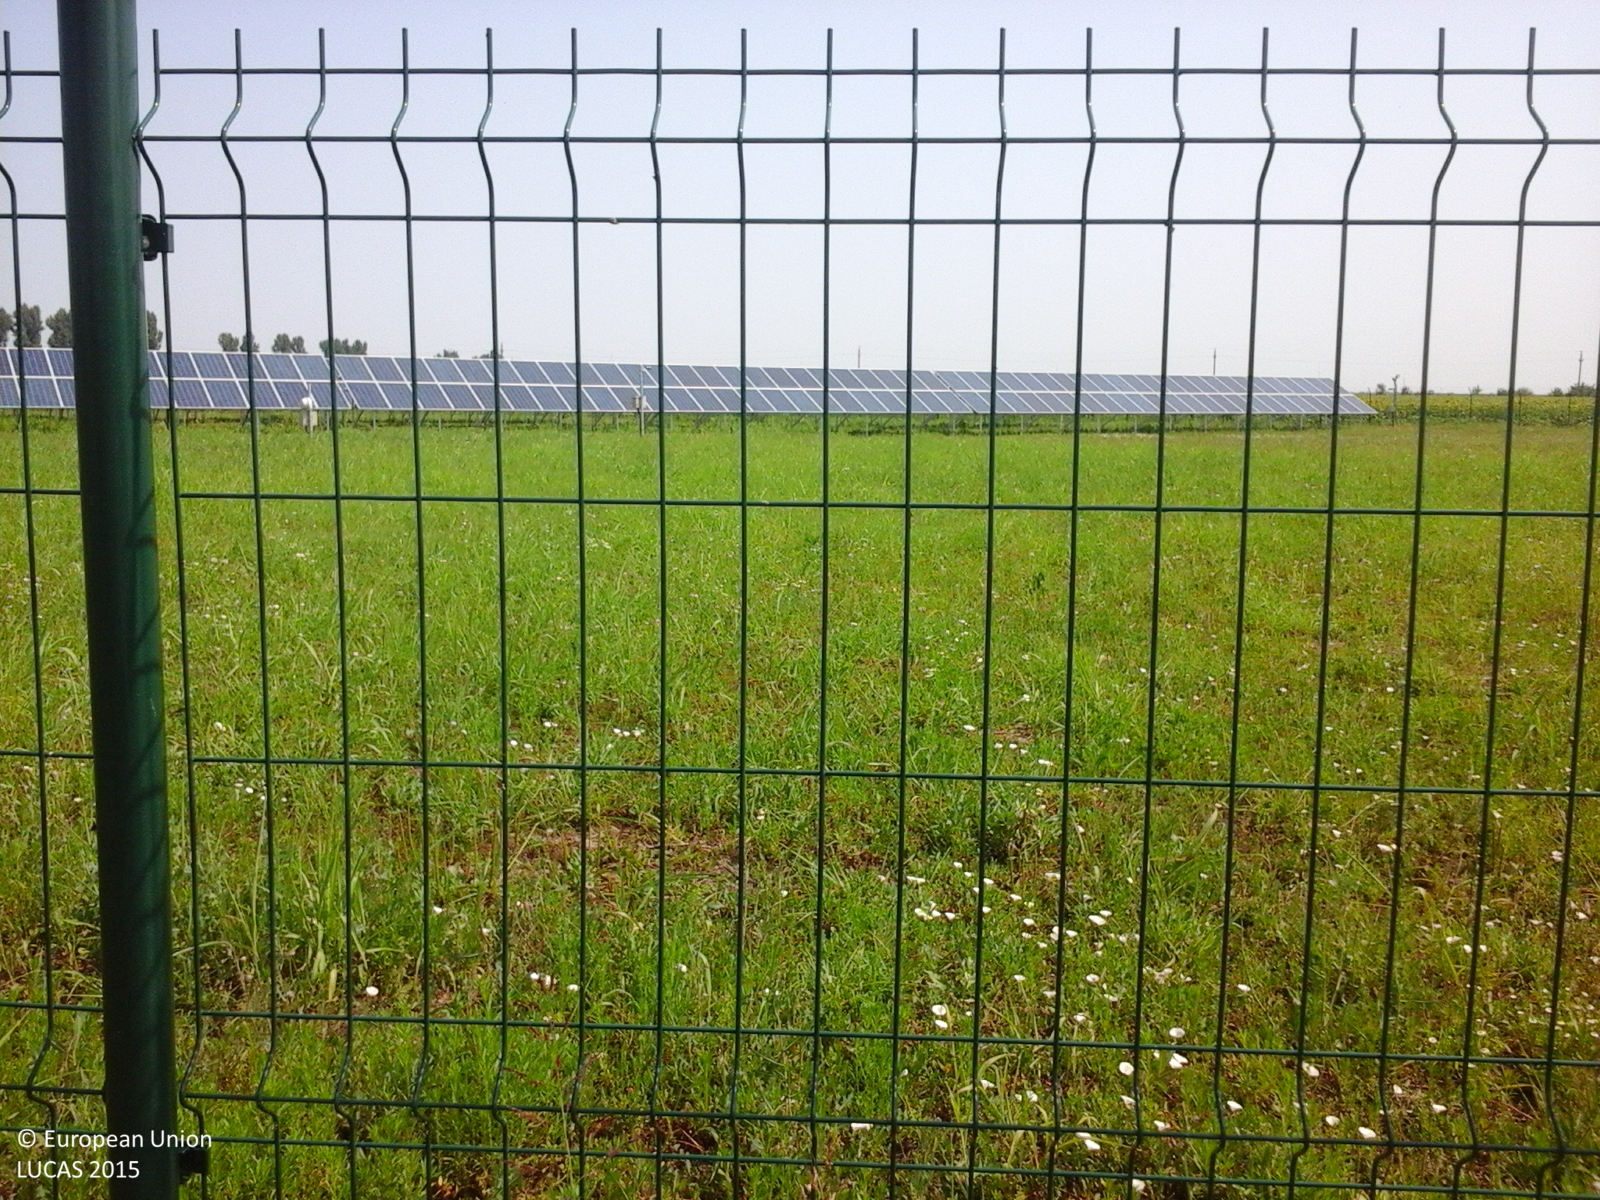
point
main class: Artificial land
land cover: Other artificial areas
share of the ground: > 75 %
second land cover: Grassland without tree/shrub cover
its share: > 75 %
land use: Energy production
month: July
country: RO
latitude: 44.7287
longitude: 26.4944
